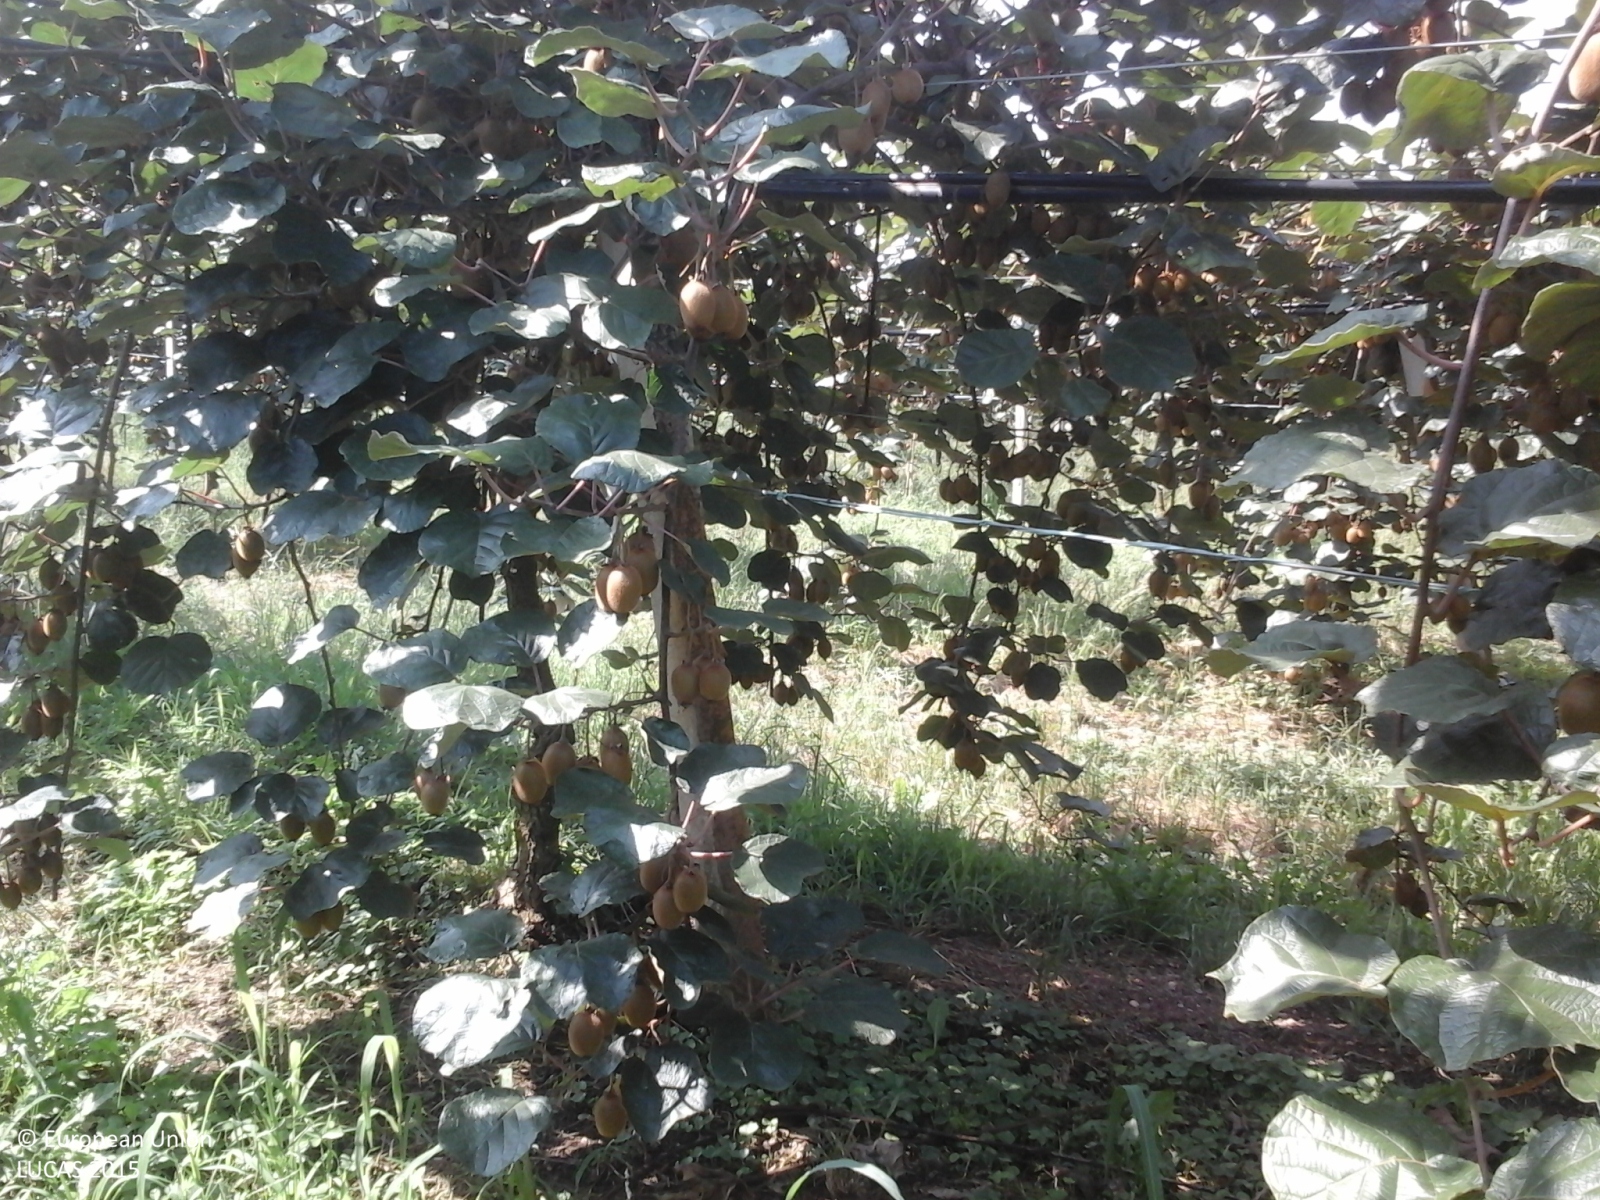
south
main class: Cropland
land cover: Other fruit trees and berries
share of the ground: > 75 %
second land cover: Grassland without tree/shrub cover
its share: > 75 %
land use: Agriculture (excluding fallow land and kitchen gardens)
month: July
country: IT
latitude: 45.3211
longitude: 10.8023
